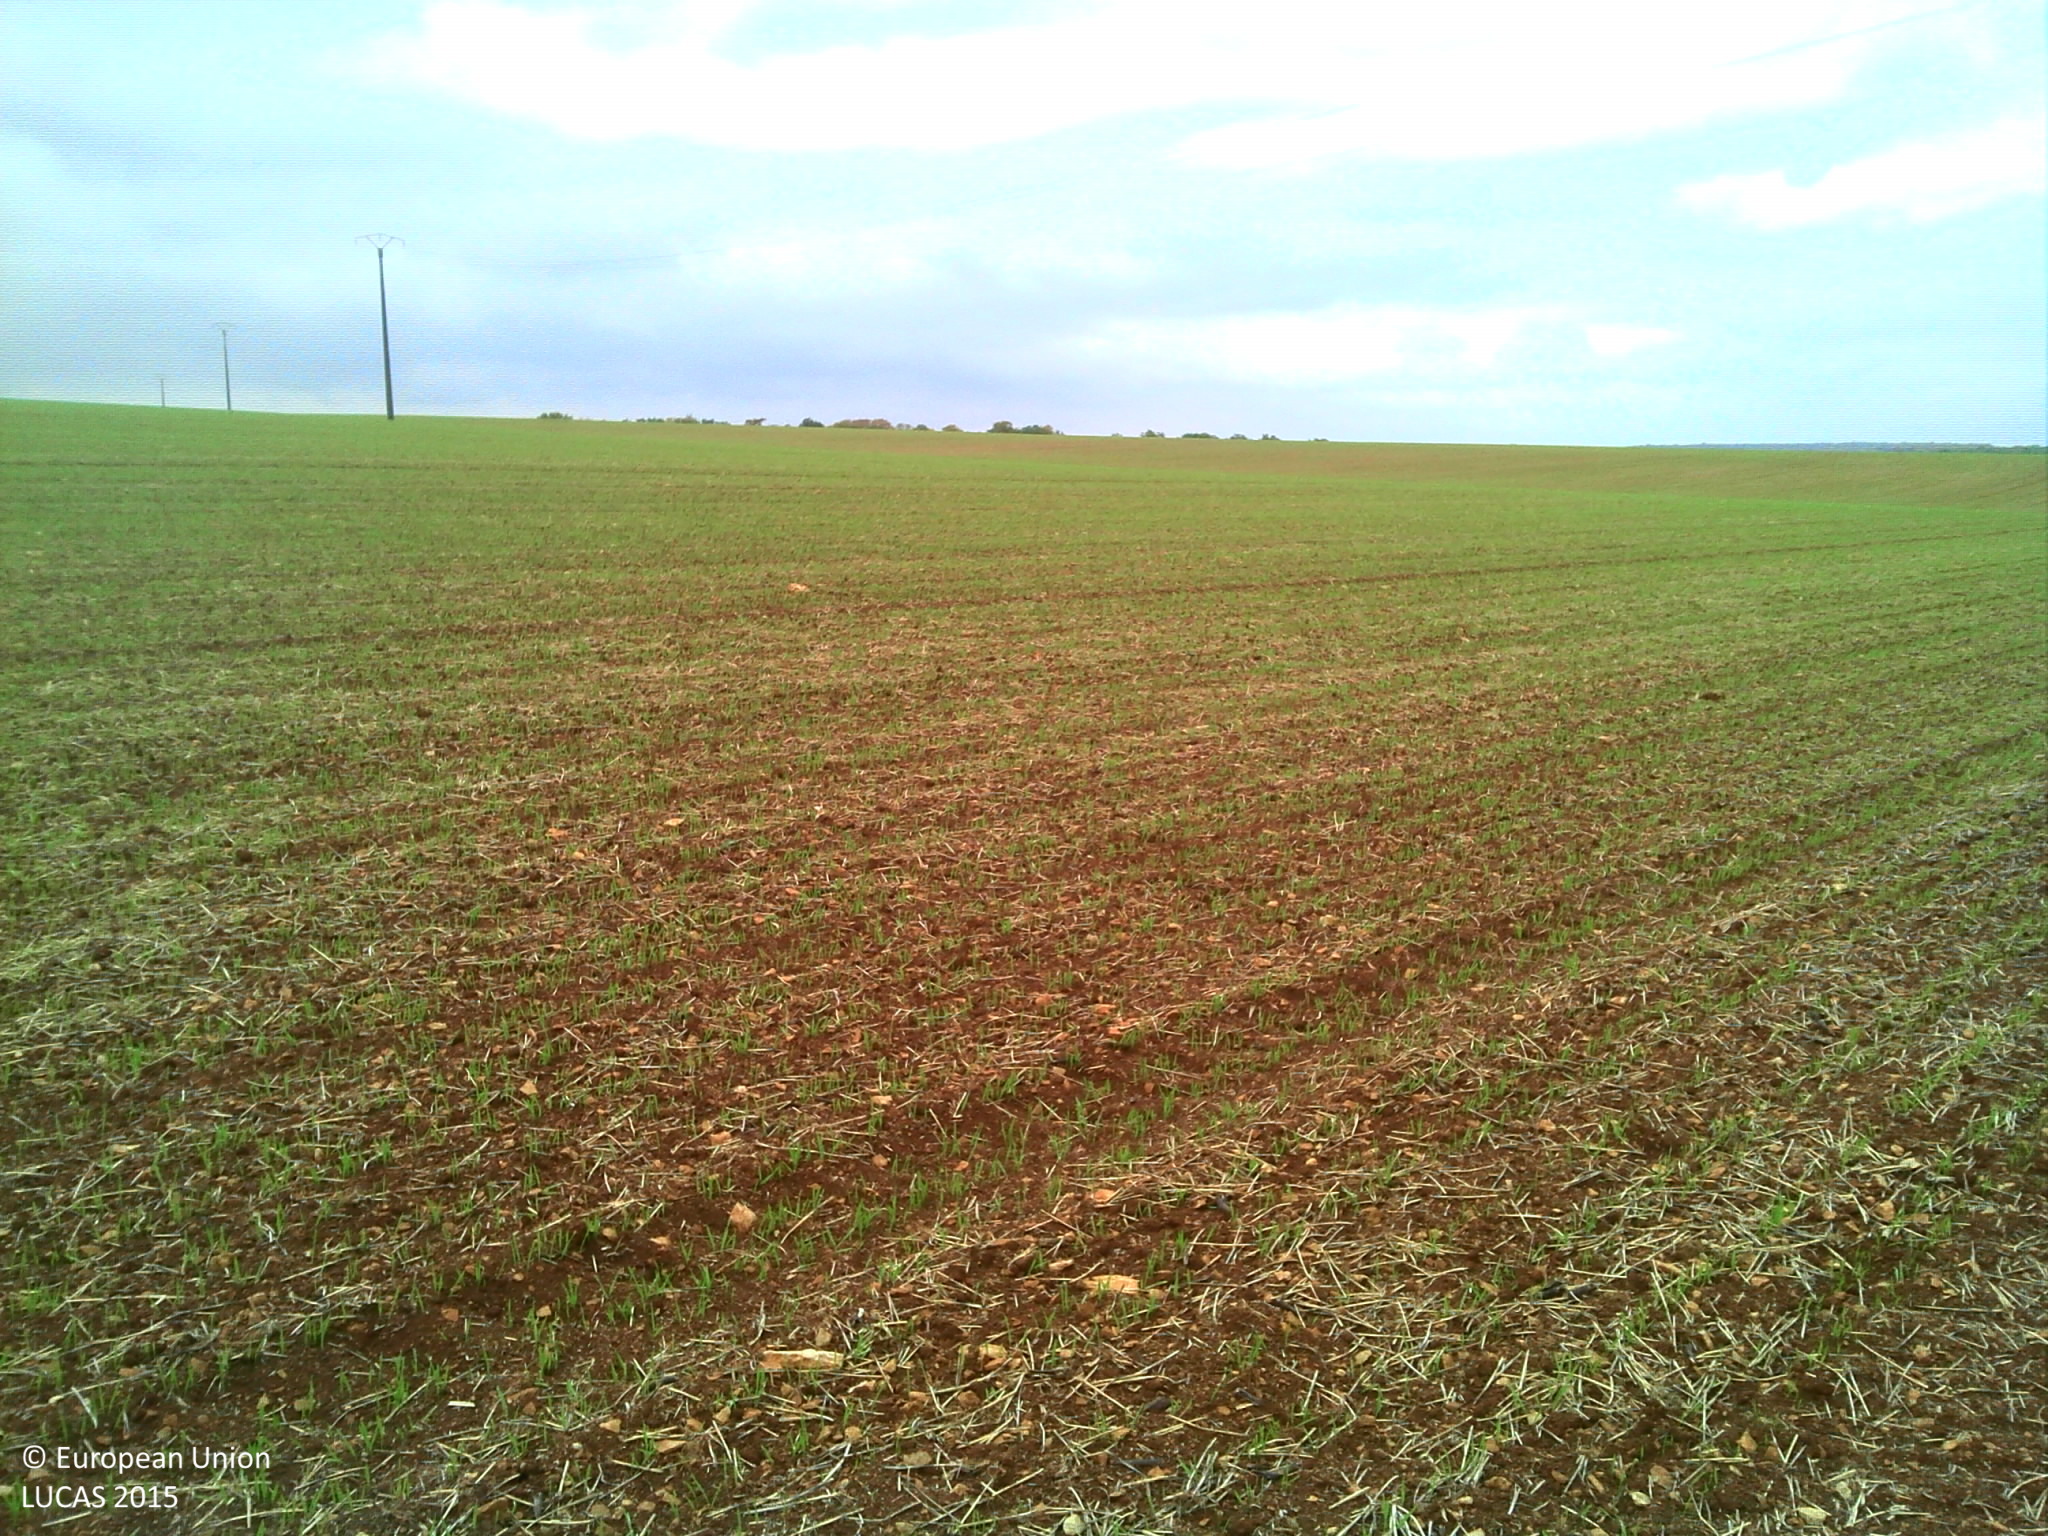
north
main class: Cropland
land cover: Common wheat
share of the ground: 10 - 25 %
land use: Agriculture (excluding fallow land and kitchen gardens)
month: October
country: FR
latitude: 47.5519
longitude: 5.0169
